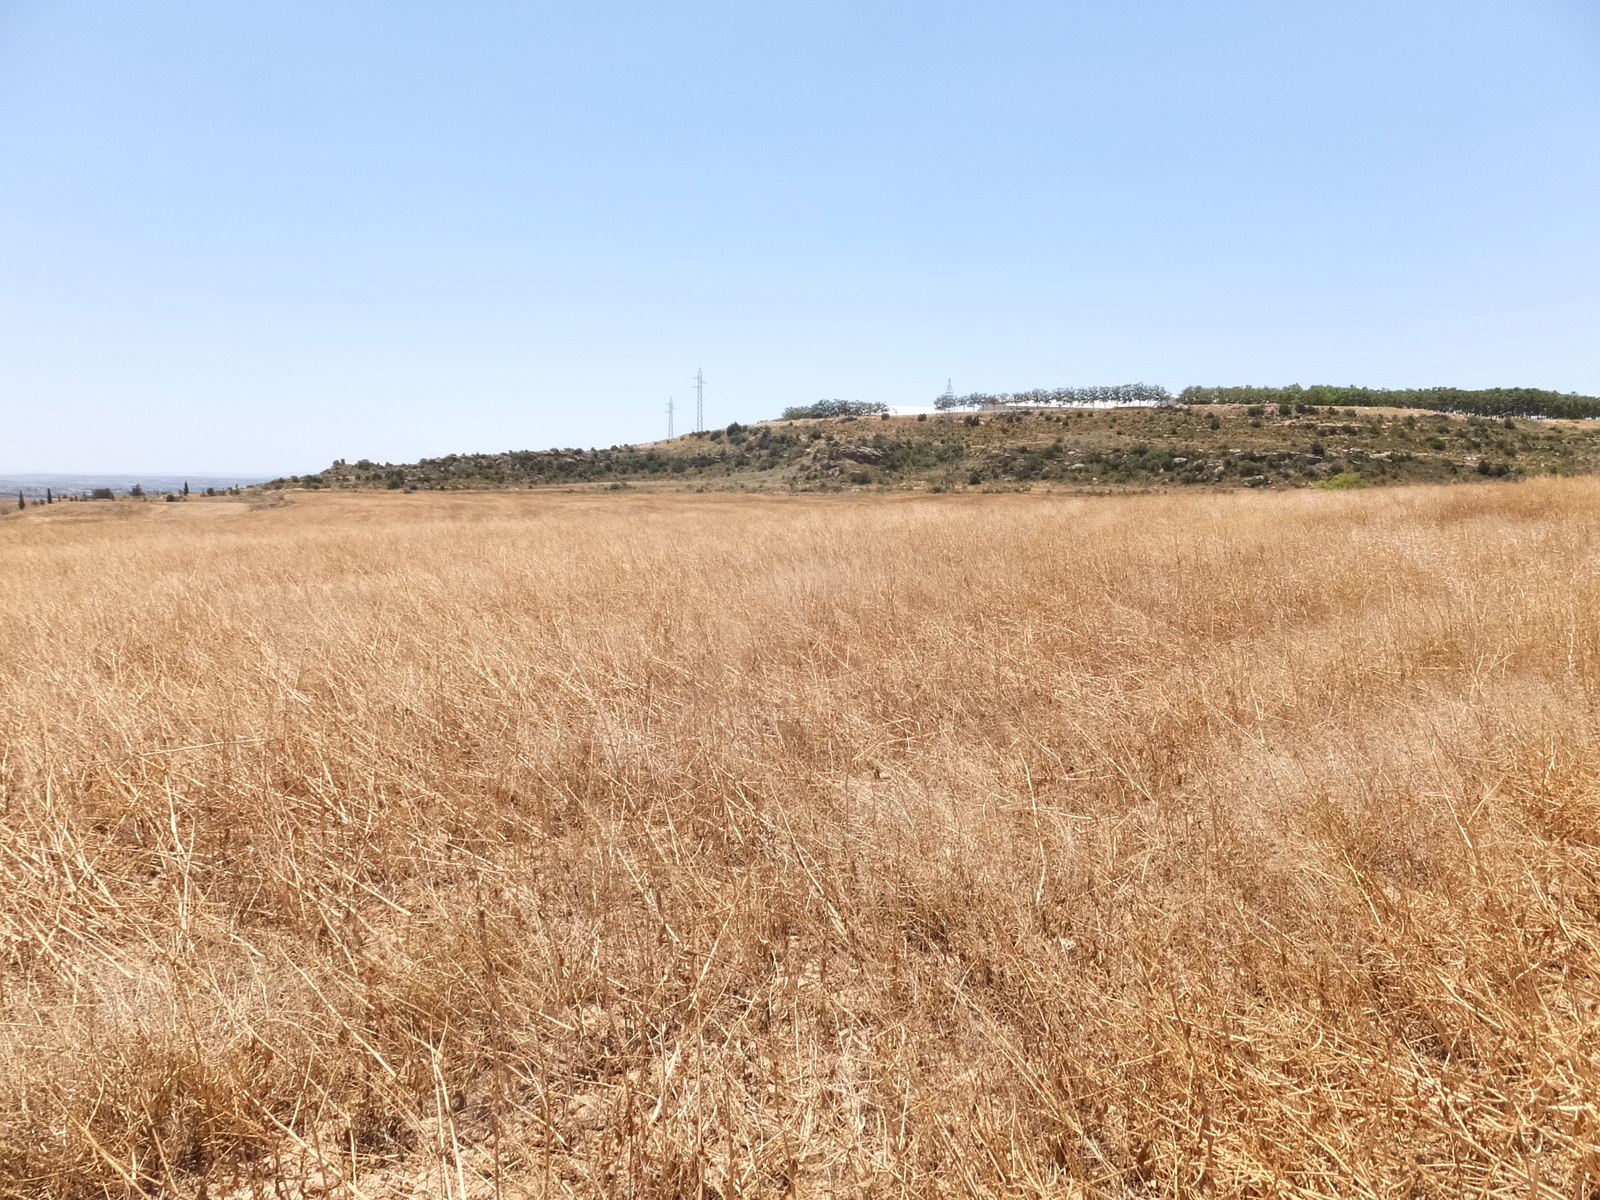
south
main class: Grassland
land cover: Spontaneously vegetated surfaces
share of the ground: > 75 %
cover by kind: herbaceous plants 90 %, unconsolidated bare surface 10 %
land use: Fallow land
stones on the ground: < 10 %
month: June
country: ES
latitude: 41.2948
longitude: -0.0802
